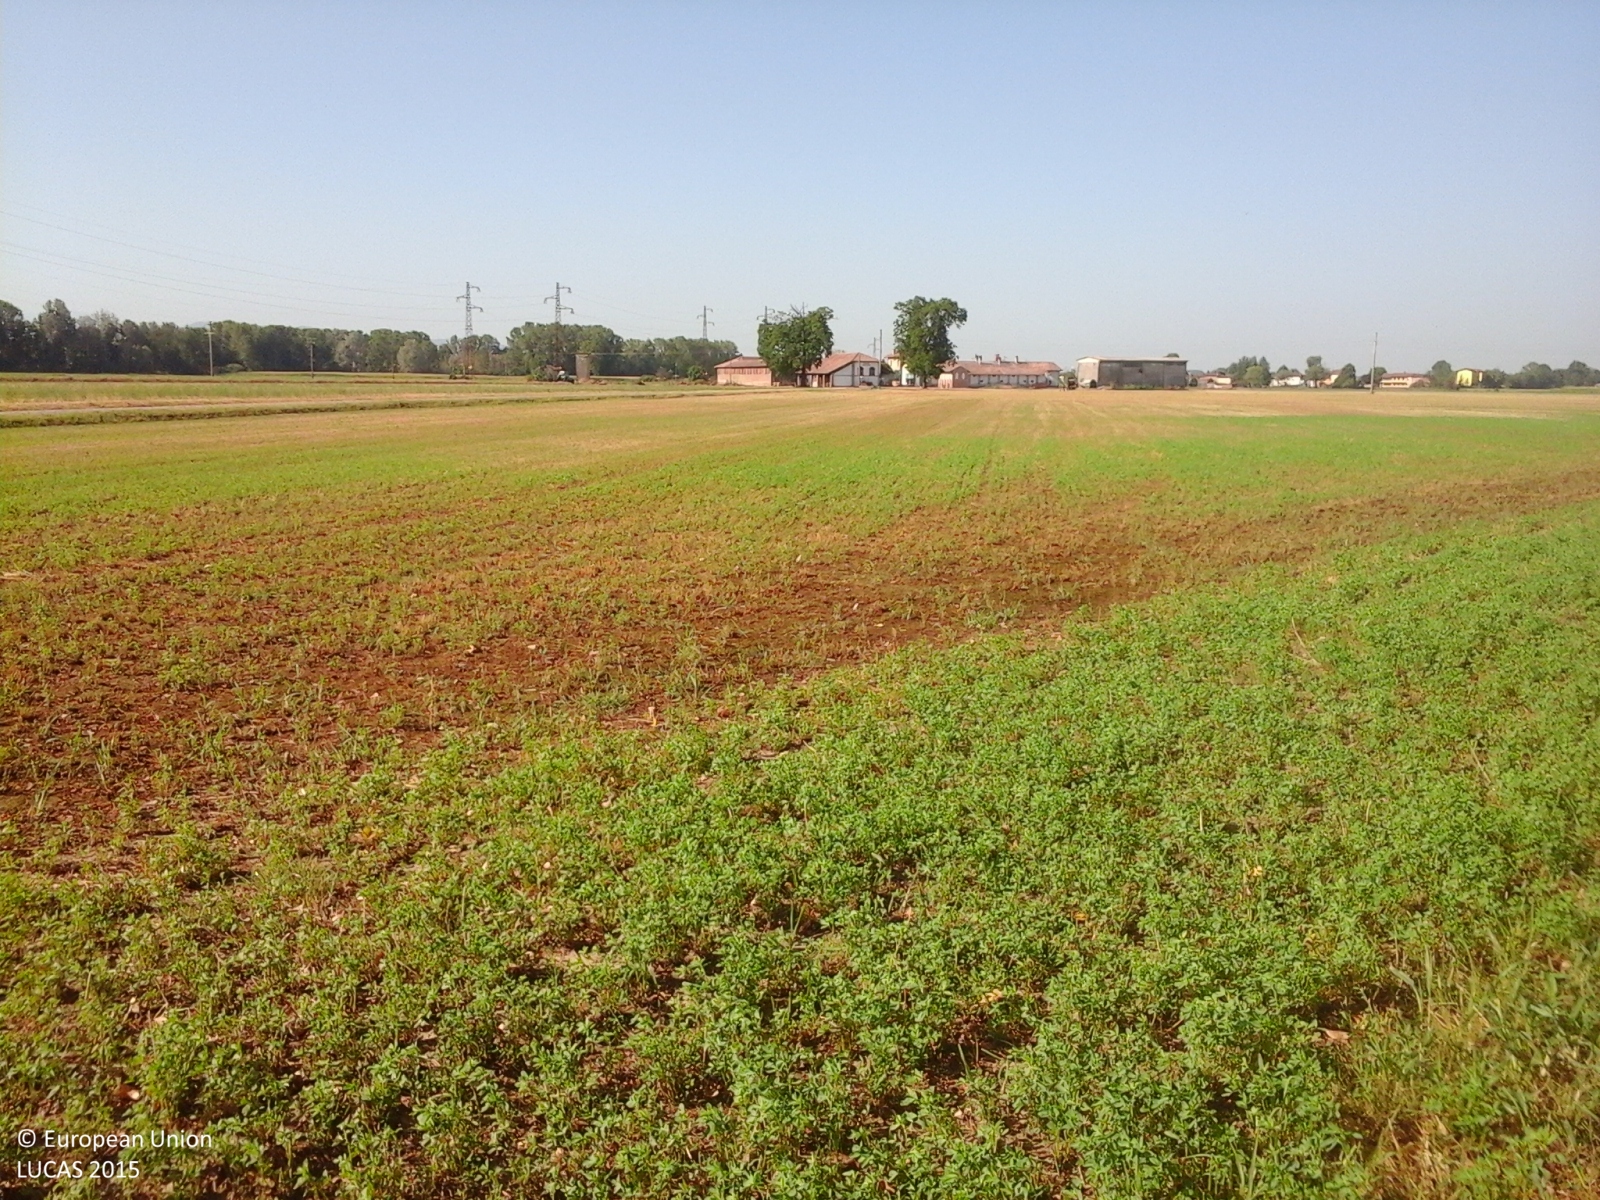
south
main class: Cropland
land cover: Lucerne
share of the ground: > 75 %
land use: Agriculture (excluding fallow land and kitchen gardens)
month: July
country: IT
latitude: 45.0860
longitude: 9.0997
